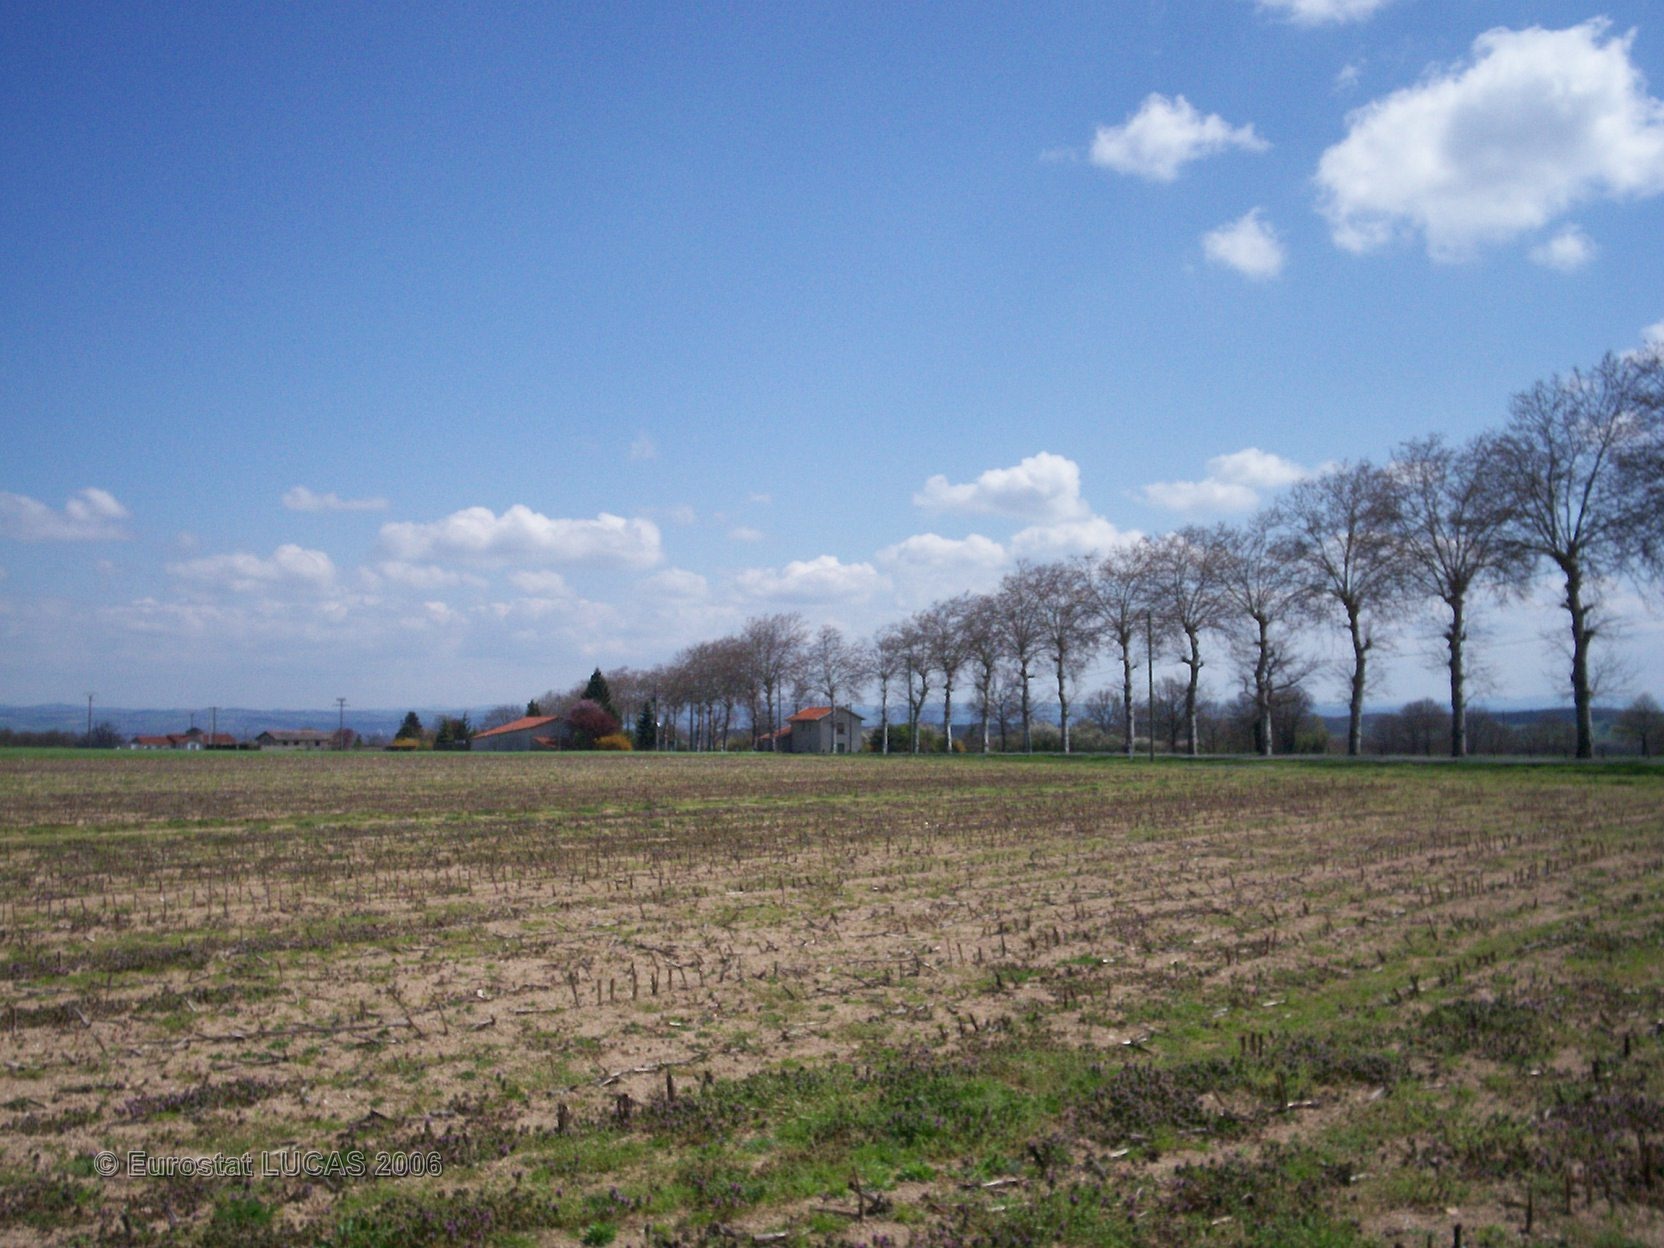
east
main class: Bare land
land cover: Bare land
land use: Fallow land
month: April
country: FR
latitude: 45.7385
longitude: 4.1292
